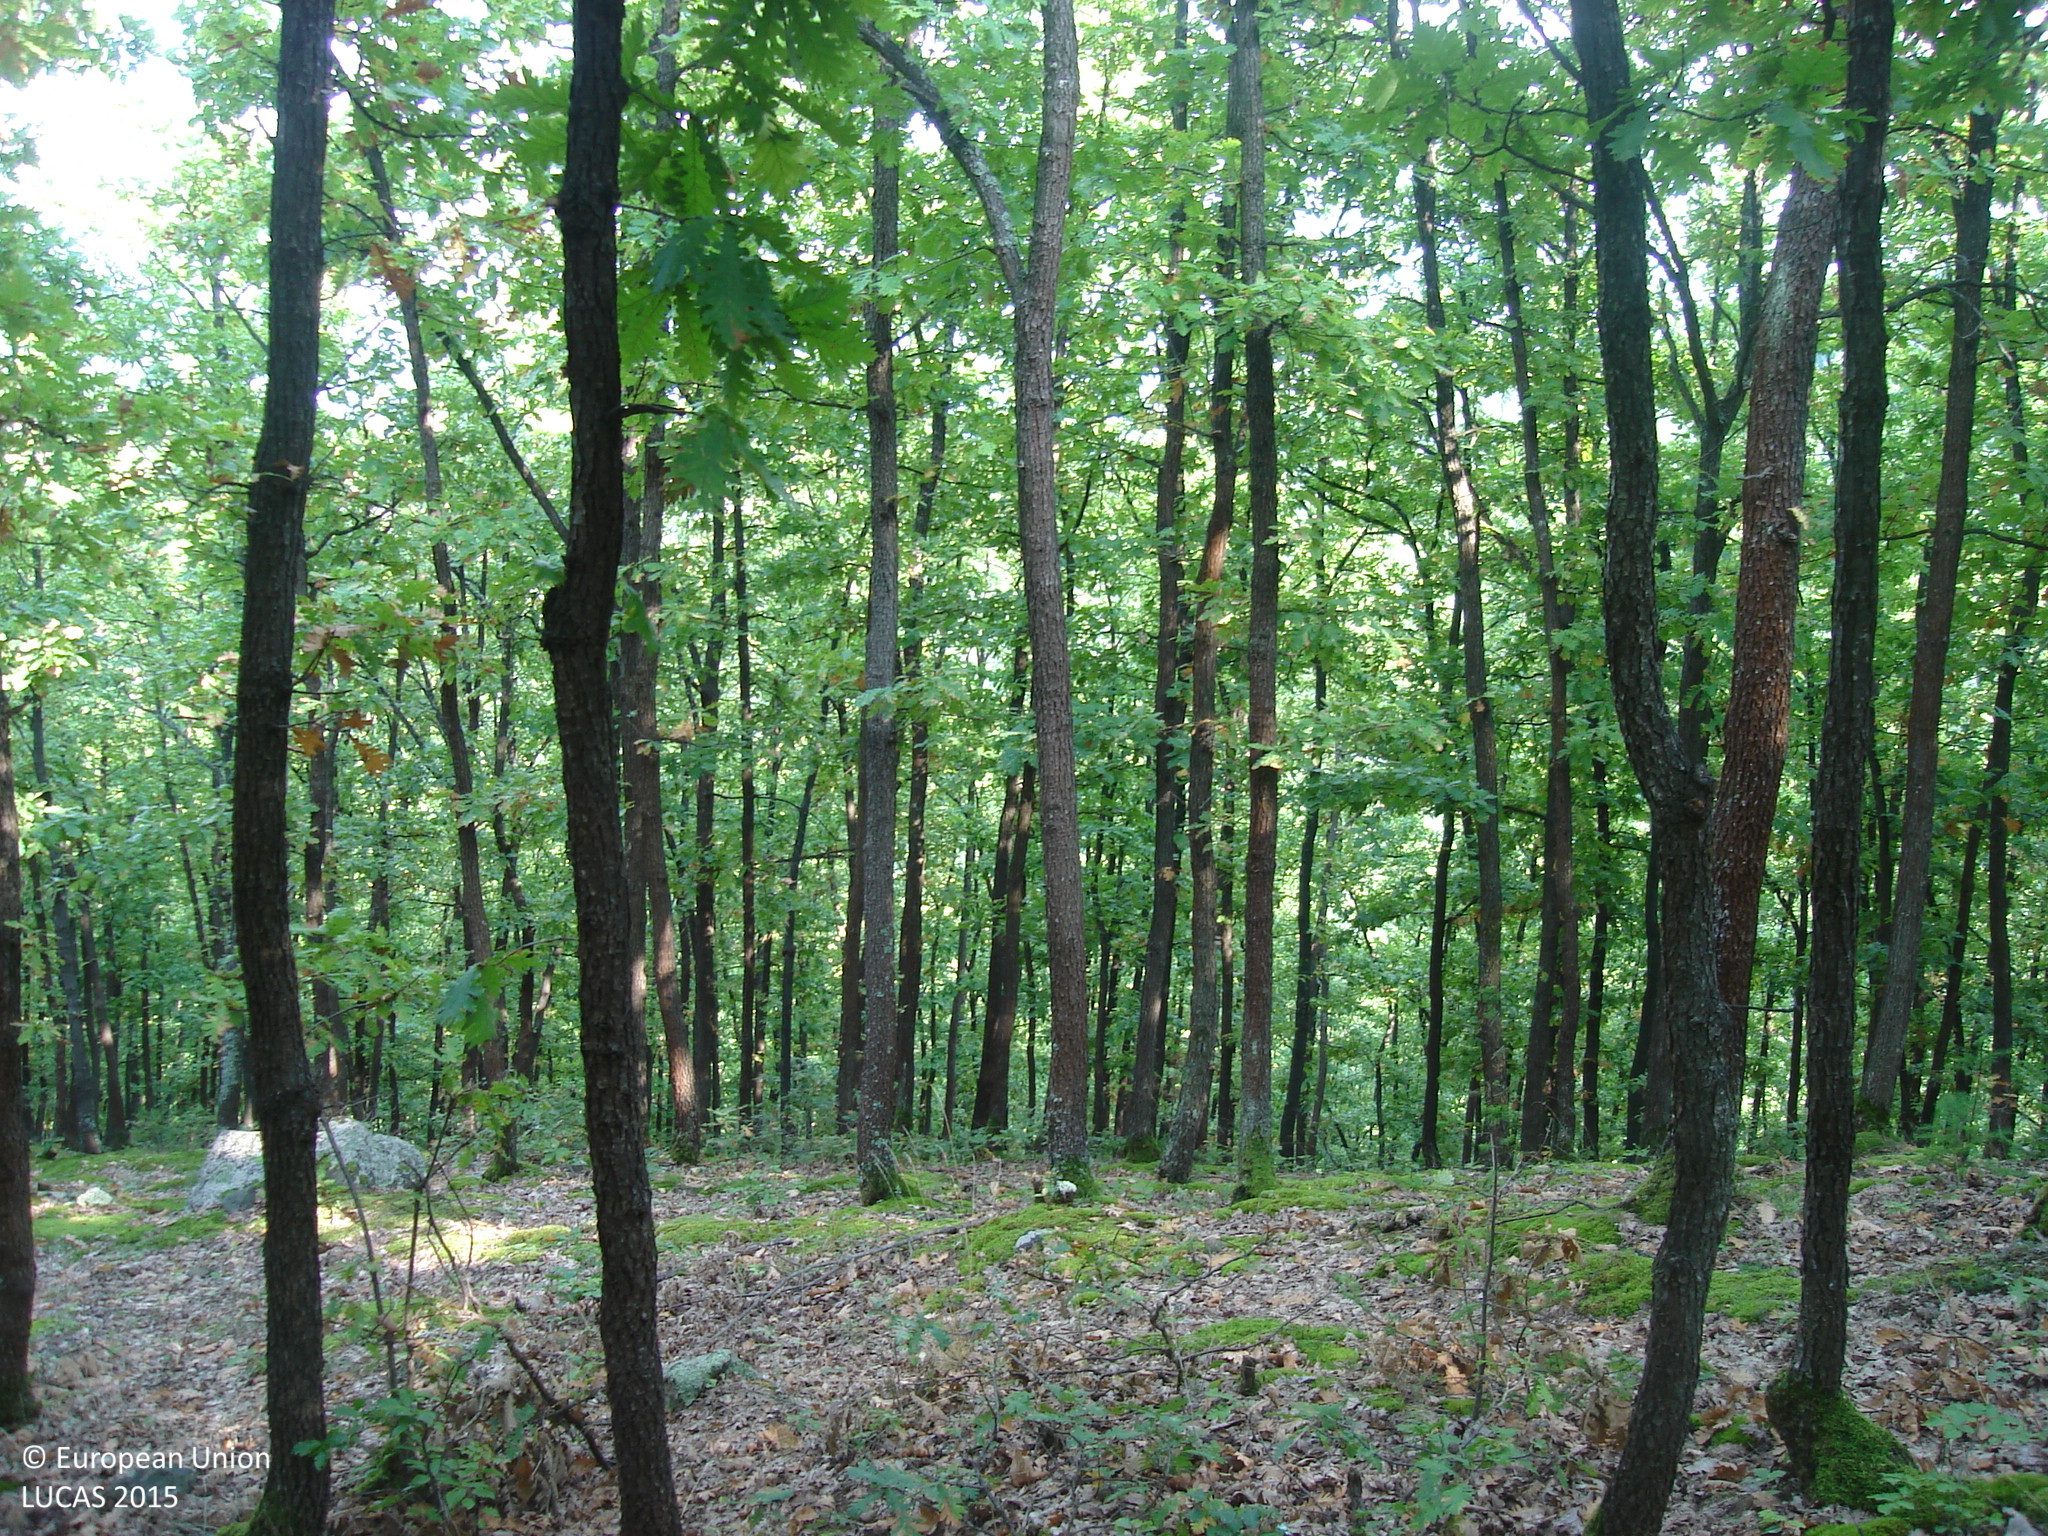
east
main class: Woodland
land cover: Broadleaved woodland
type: mesophytic deciduous forest
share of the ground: > 75 %
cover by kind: broadleaved forest trees 80 %, consolidated bare surface 20 %
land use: Forestry
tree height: > 5 m
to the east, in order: Broadleaved woodland; Rivers and streams; Broadleaved woodland; Tracks; Broadleaved woodland; Tracks; Spruce dominated coniferous woodland
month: September
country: BG
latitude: 42.9555
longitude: 23.3368
